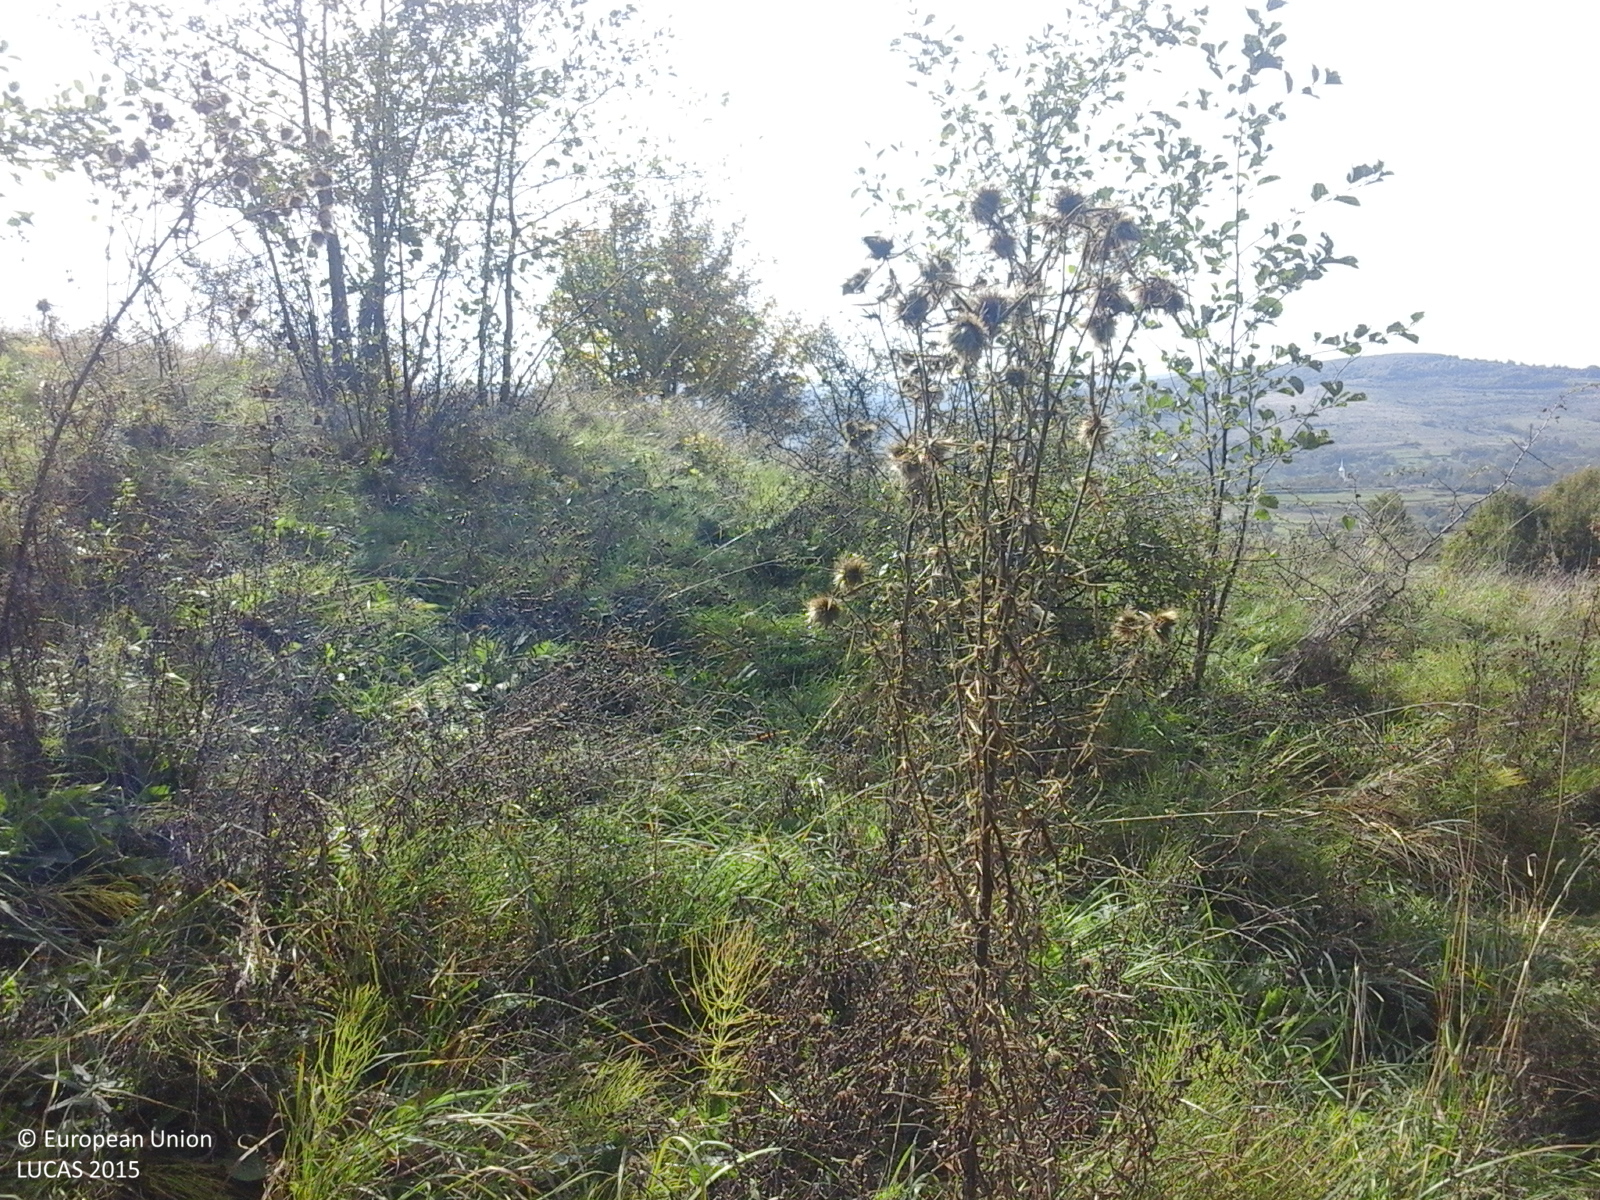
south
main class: Grassland
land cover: Grassland with sparse tree/shrub cover
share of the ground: > 75 %
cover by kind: herbaceous plants 85 %, shrubs 10 %, broadleaved forest trees 5 %
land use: Fallow land
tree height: > 5 m
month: October
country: RO
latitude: 46.4387
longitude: 25.1330
